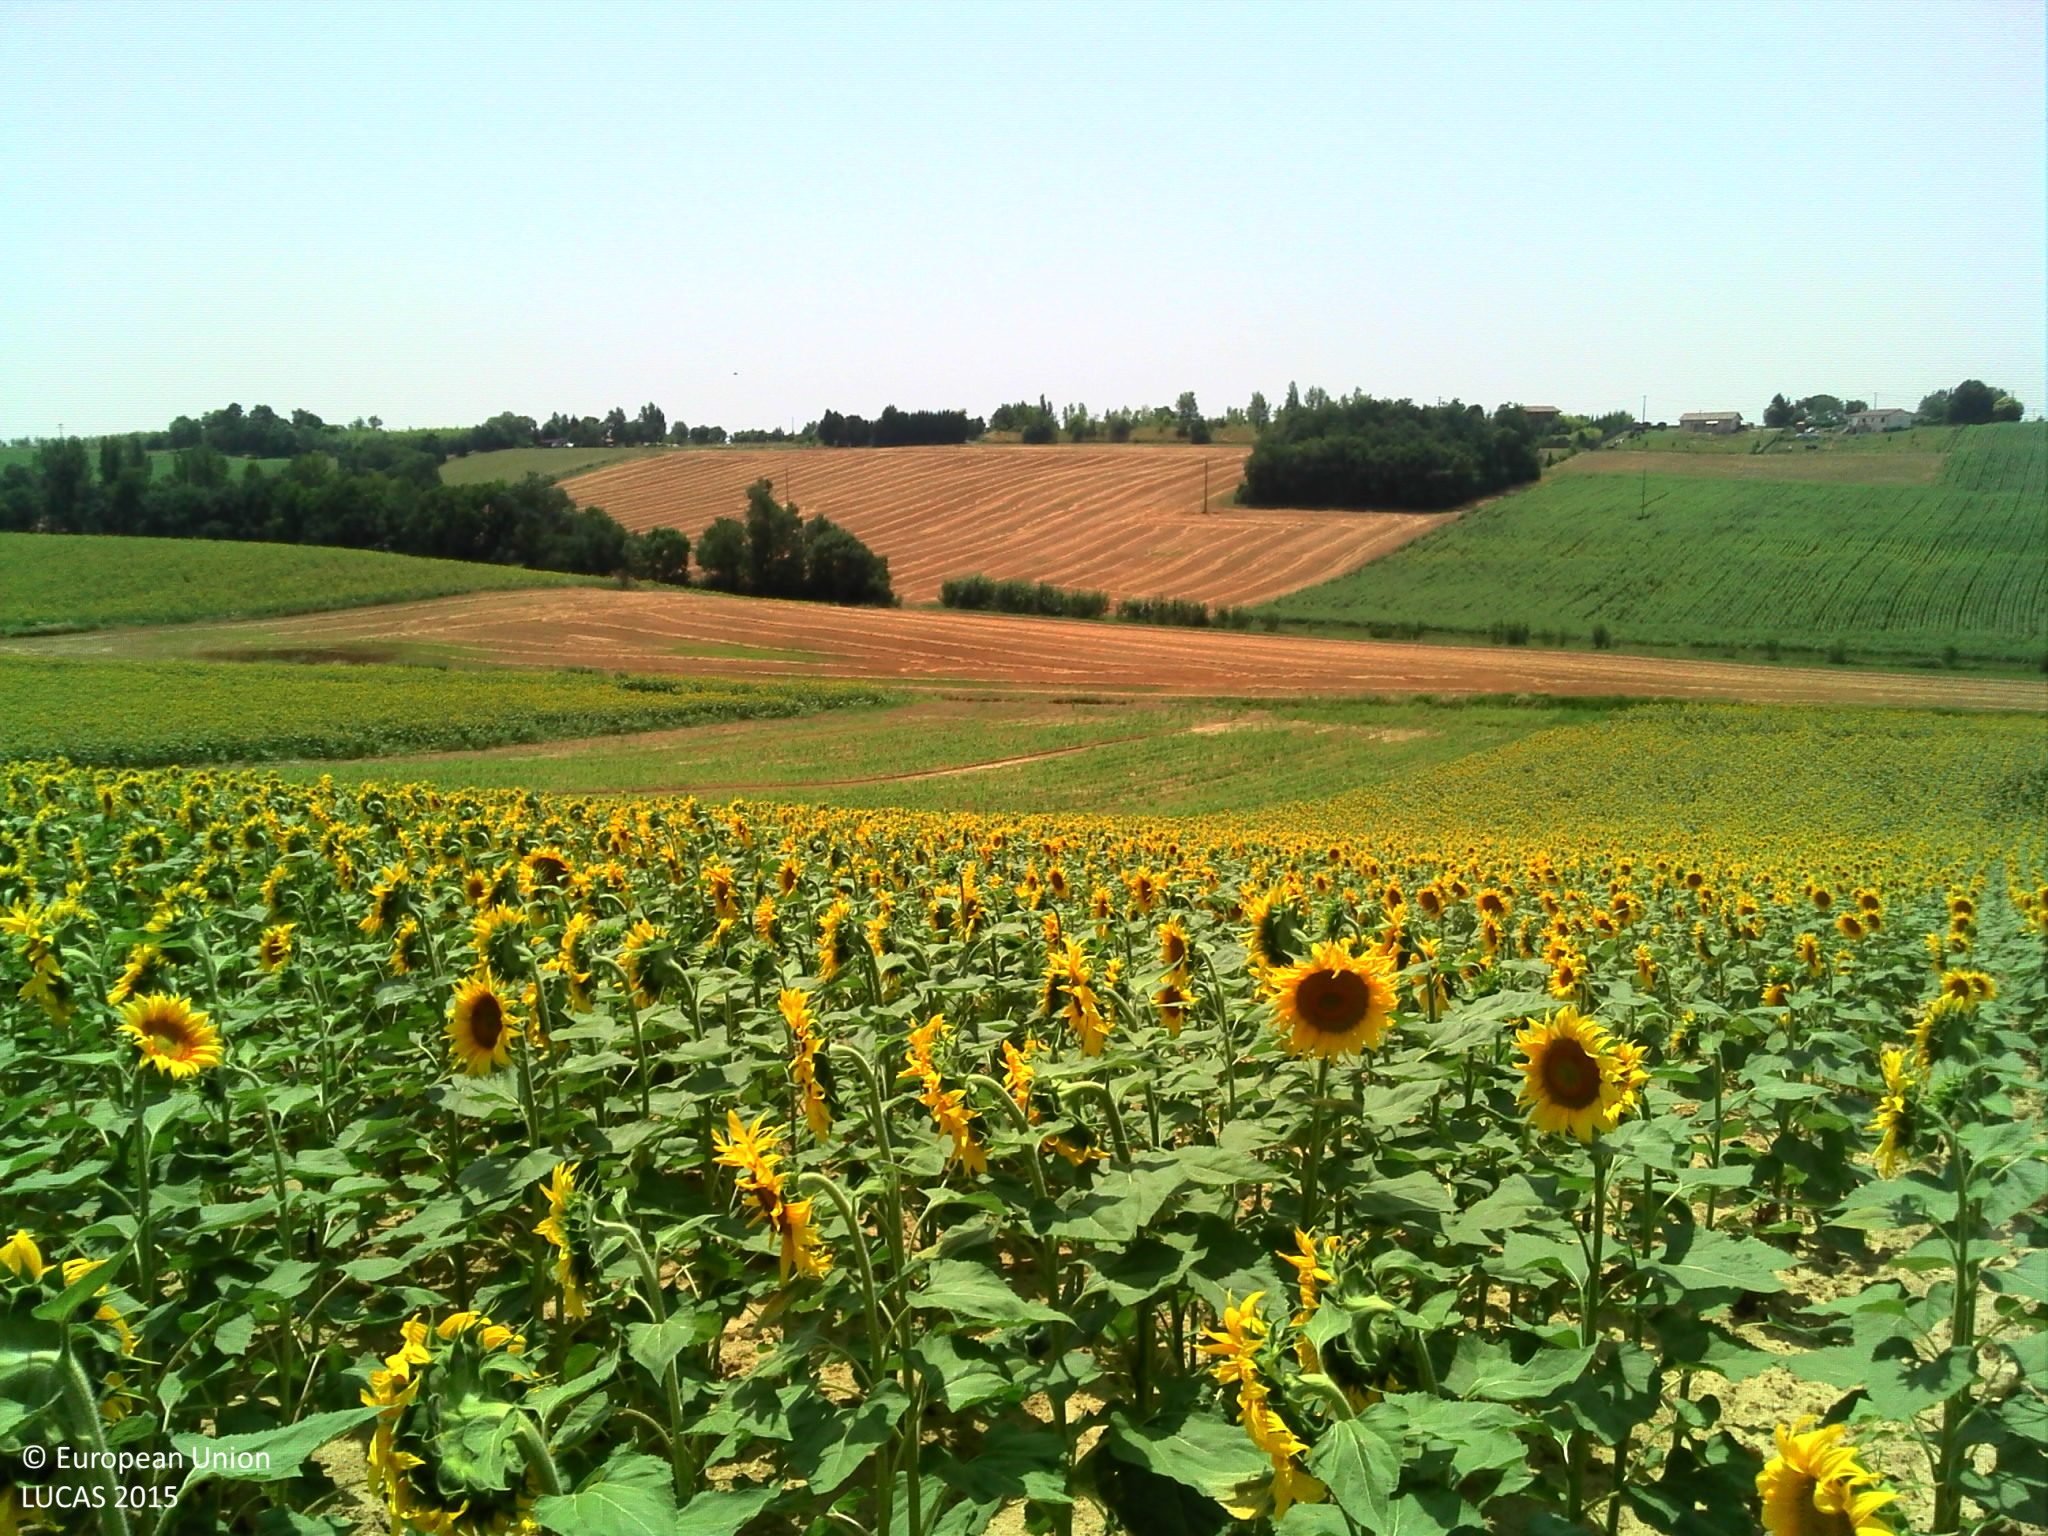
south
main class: Cropland
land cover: Sunflower
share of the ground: > 75 %
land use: Agriculture (excluding fallow land and kitchen gardens)
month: July
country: FR
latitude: 43.6893
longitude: 1.0303
